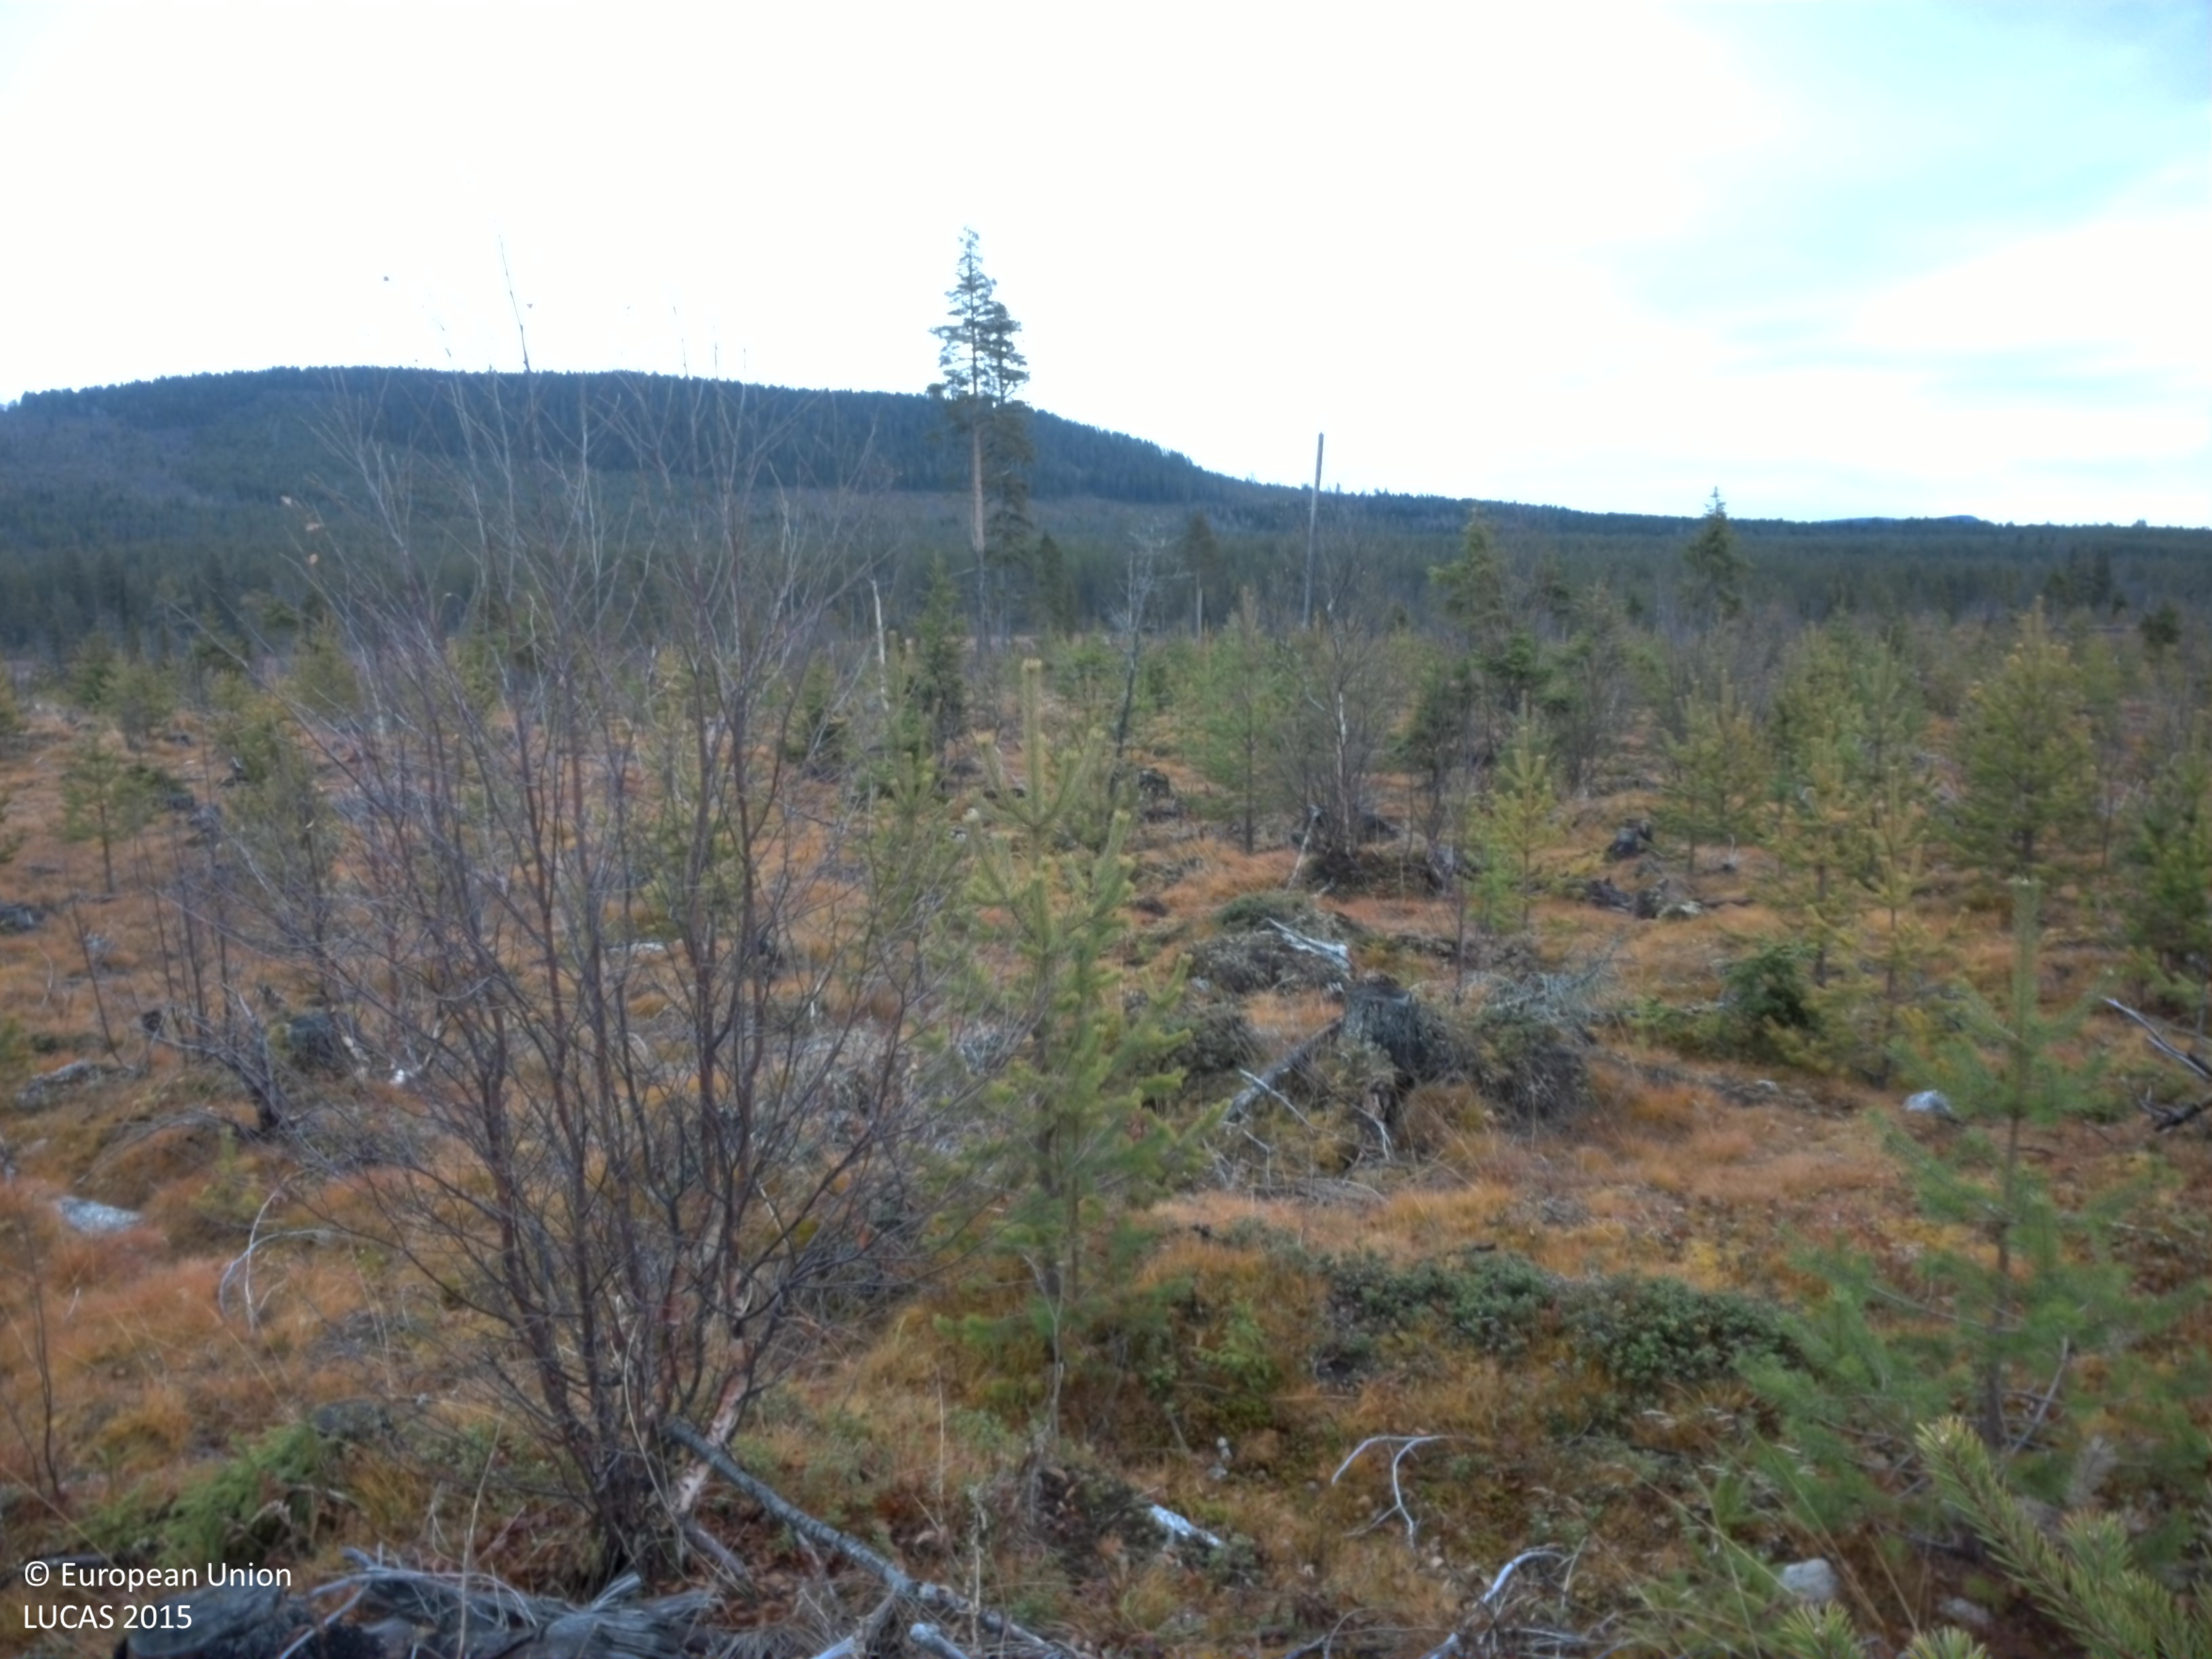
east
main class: Woodland
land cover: Pine dominated mixed woodland
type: boreal forest
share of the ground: 10 - 25 %
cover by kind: herbaceous plants 50 %, shrubs 20 %, lichens and mosses 20 %, coniferous forest trees 5 %, broadleaved forest trees 5 %
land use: Forestry
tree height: < 5 m
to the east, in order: Pine dominated mixed woodland; Spruce dominated mixed woodland; Shrubland with sparse tree cover; Peatbogs
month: October
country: SE
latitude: 64.5157
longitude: 17.4035
